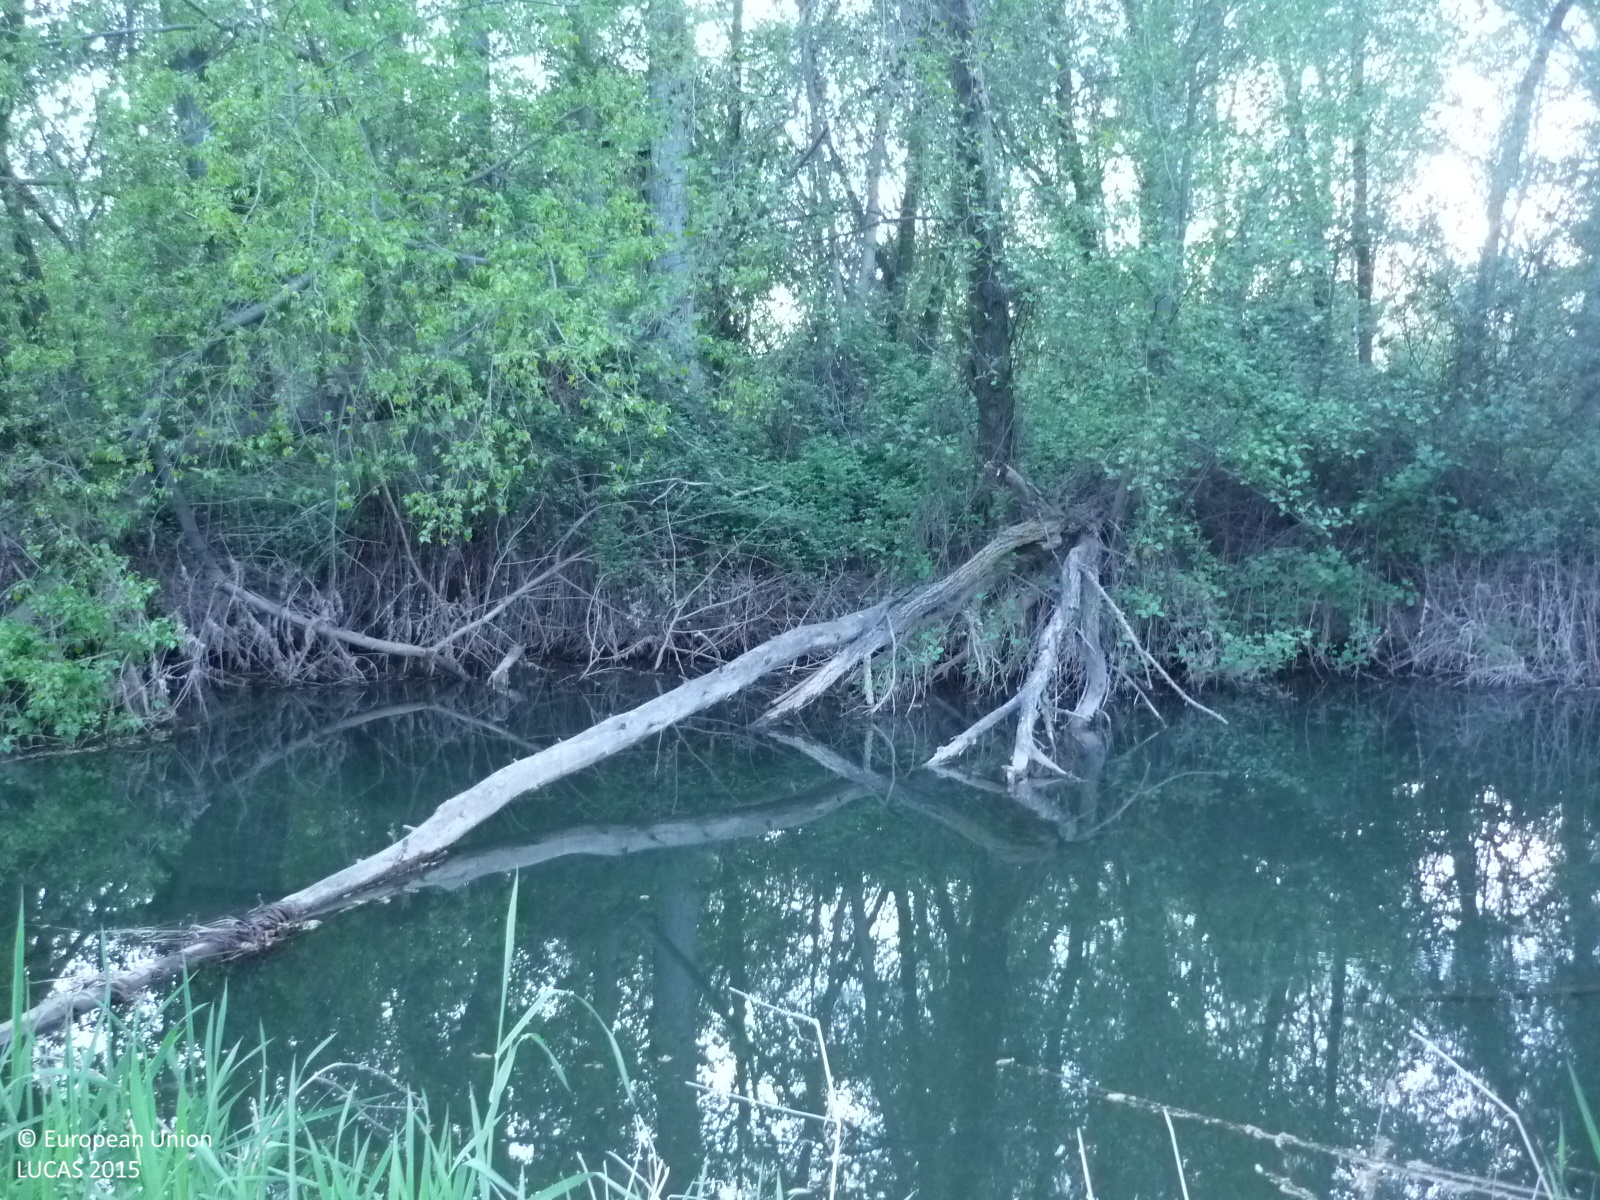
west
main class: Woodland
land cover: Broadleaved woodland
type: floodplain forest
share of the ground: > 75 %
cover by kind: broadleaved forest trees 90 %, herbaceous plants 10 %
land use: Semi-natural and natural areas not in use
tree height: > 5 m
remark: Temporary flooded
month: April
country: ES
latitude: 40.6970
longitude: -3.5421
